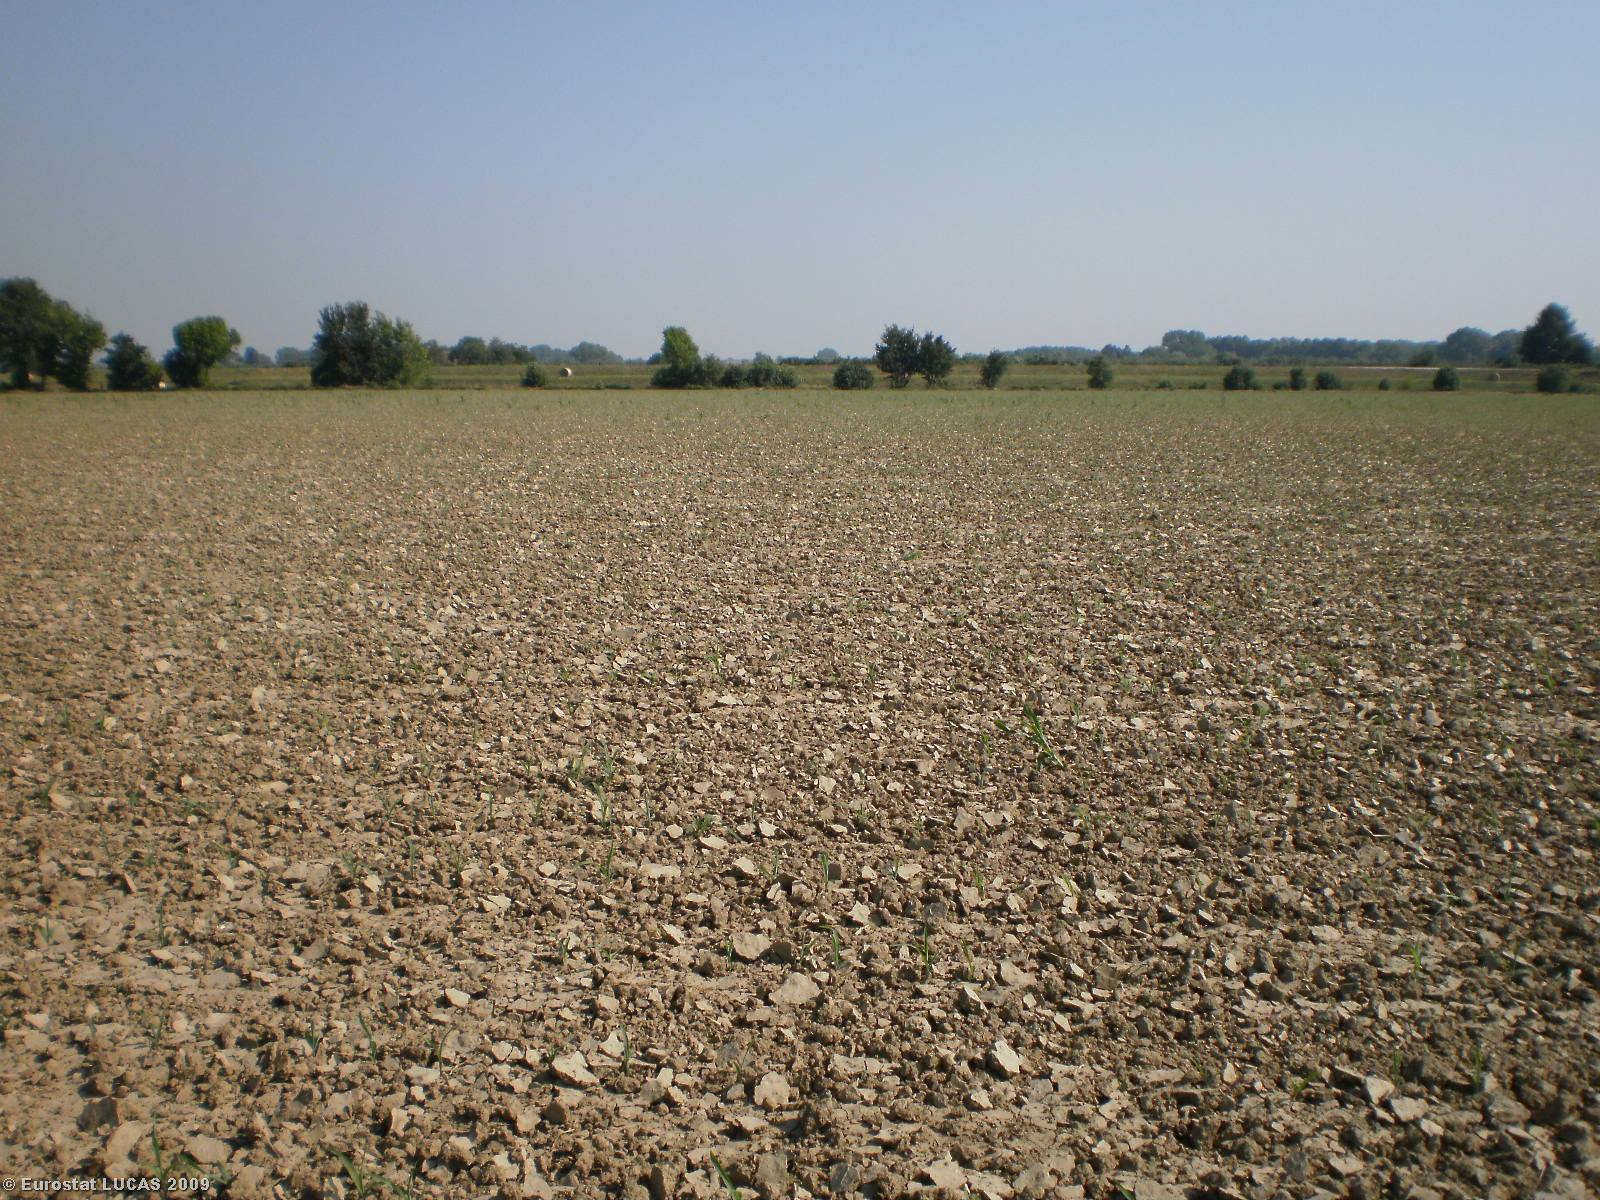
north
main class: Cropland
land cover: Maize
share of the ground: 10 - 25 %
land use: Agriculture (excluding fallow land and kitchen gardens)
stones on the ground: < 10 %
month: June
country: IT
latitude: 45.1614
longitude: 10.3428
